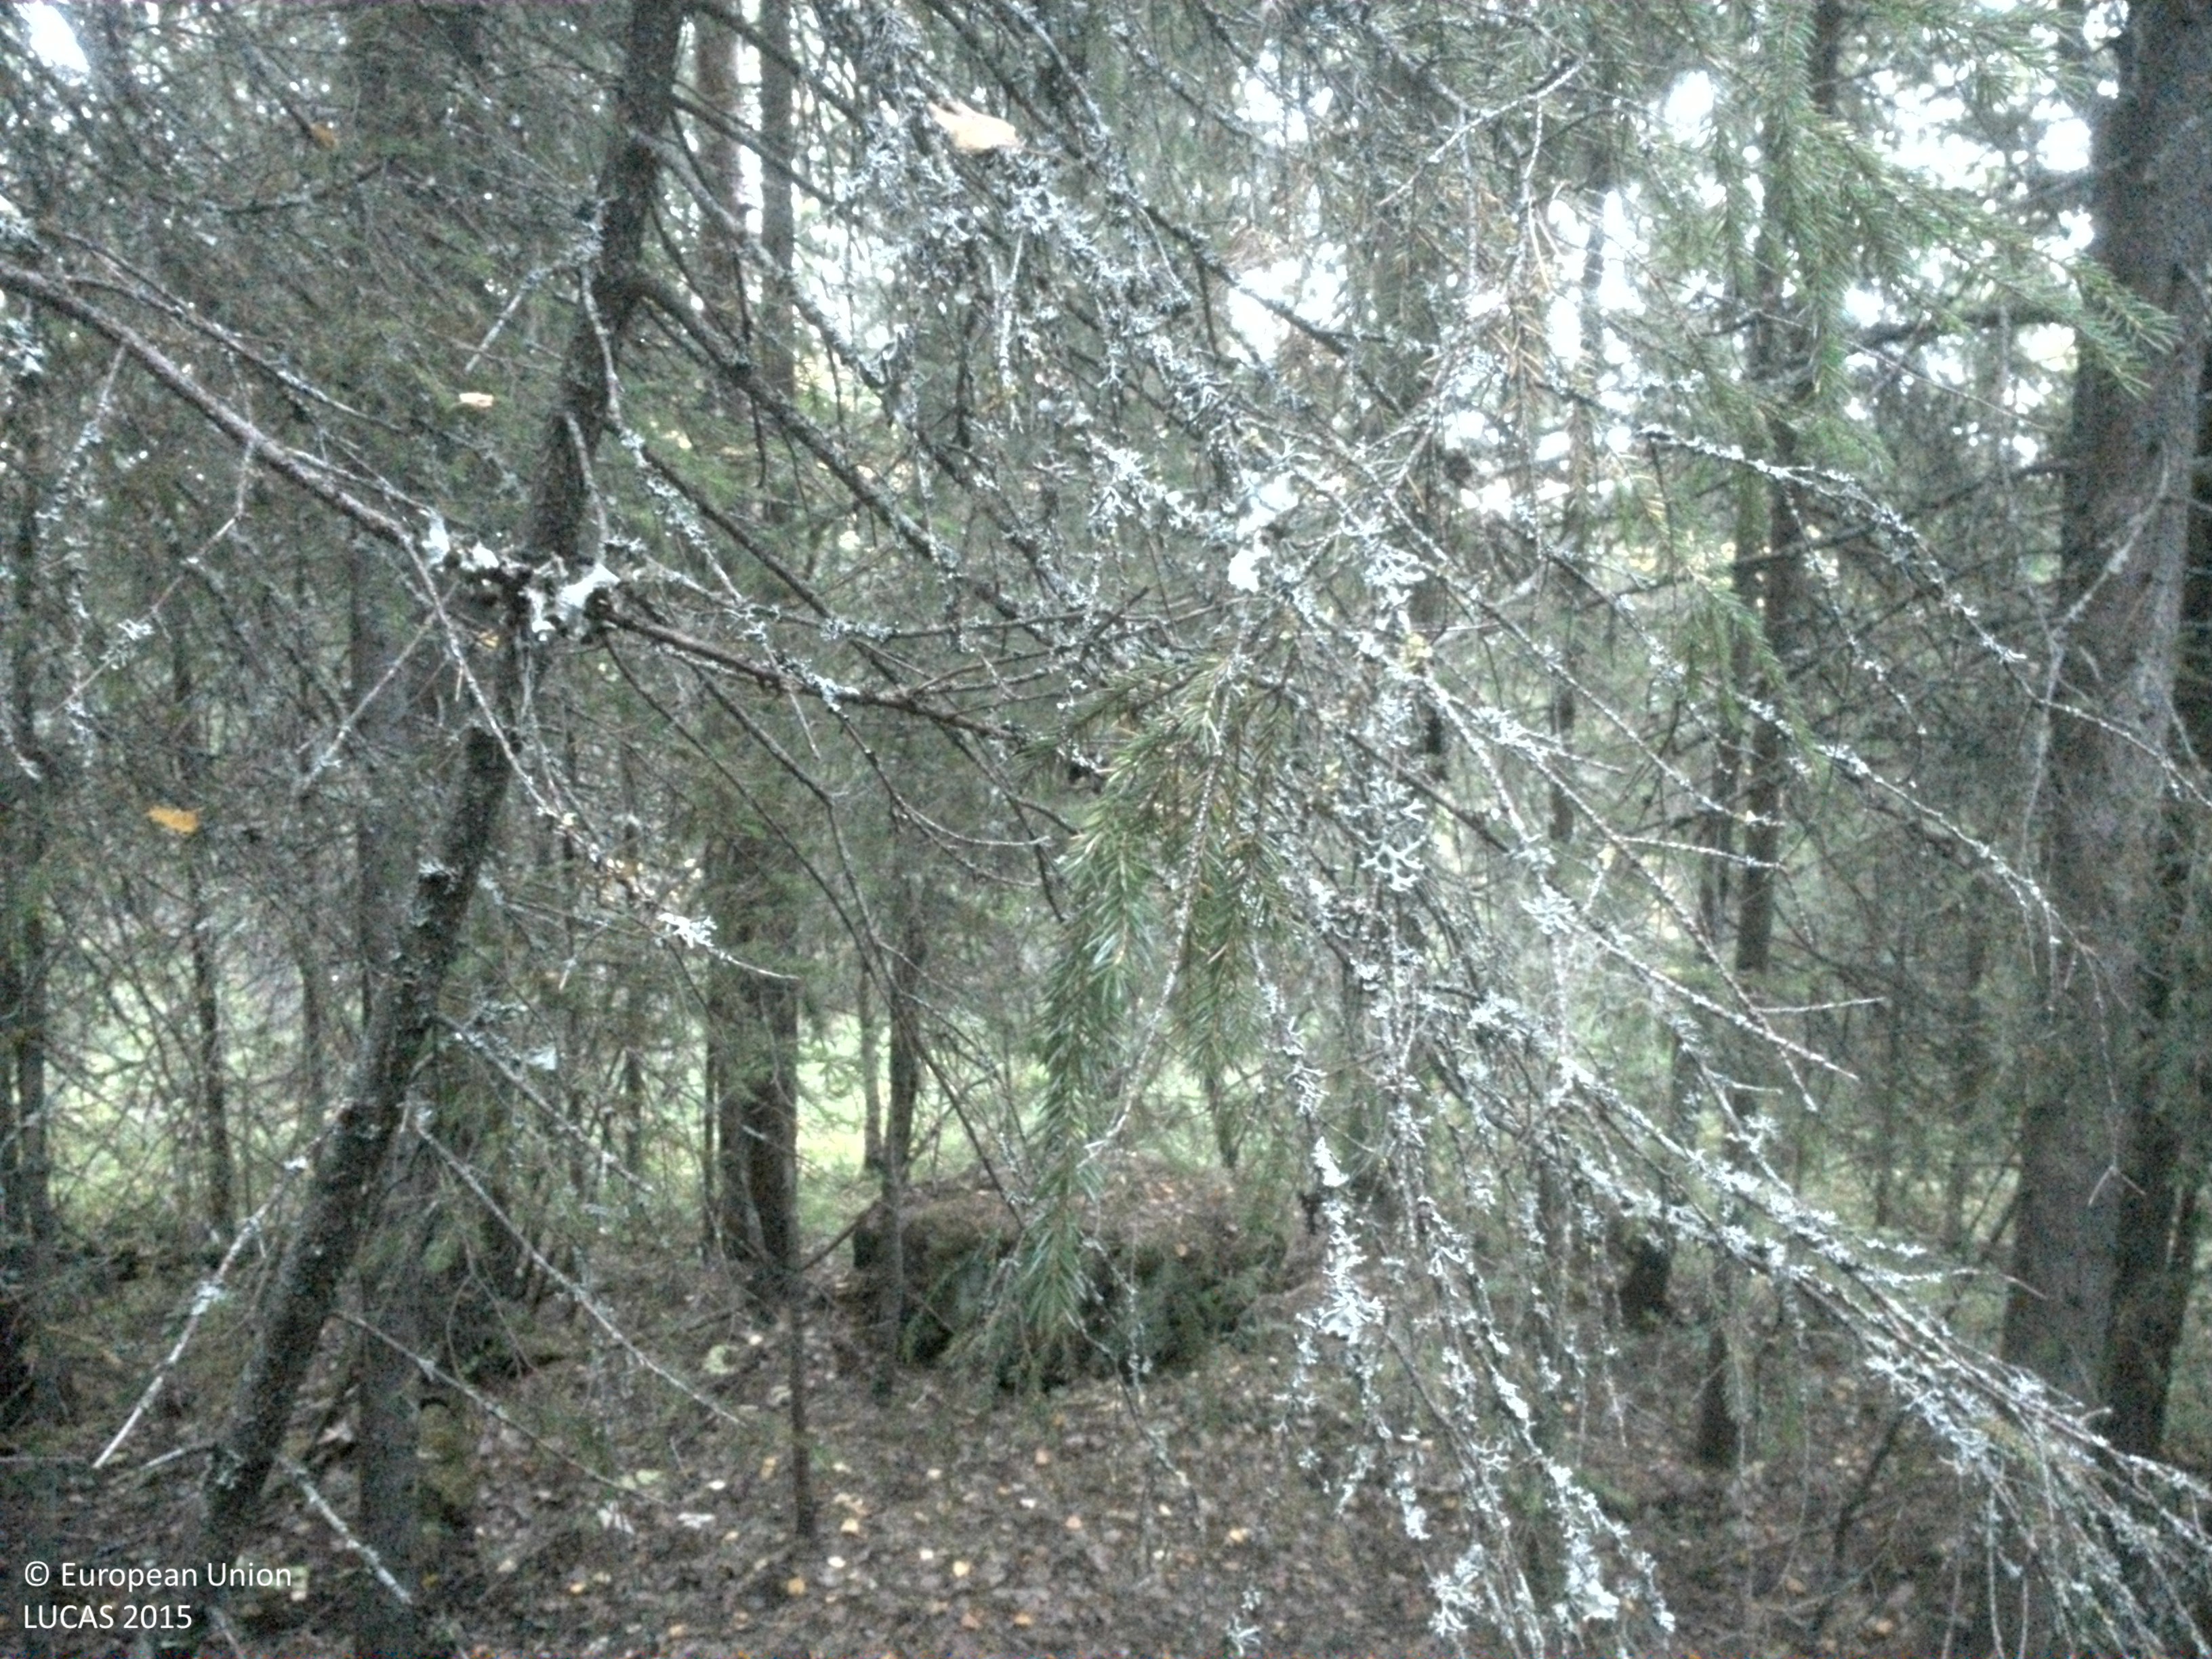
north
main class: Woodland
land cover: Spruce dominated mixed woodland
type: boreal forest
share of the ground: > 75 %
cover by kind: coniferous forest trees 60 %, broadleaved forest trees 20 %, shrubs 10 %, lichens and mosses 10 %
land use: Forestry
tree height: > 5 m
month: September
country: SE
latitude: 64.3197
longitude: 20.5479
